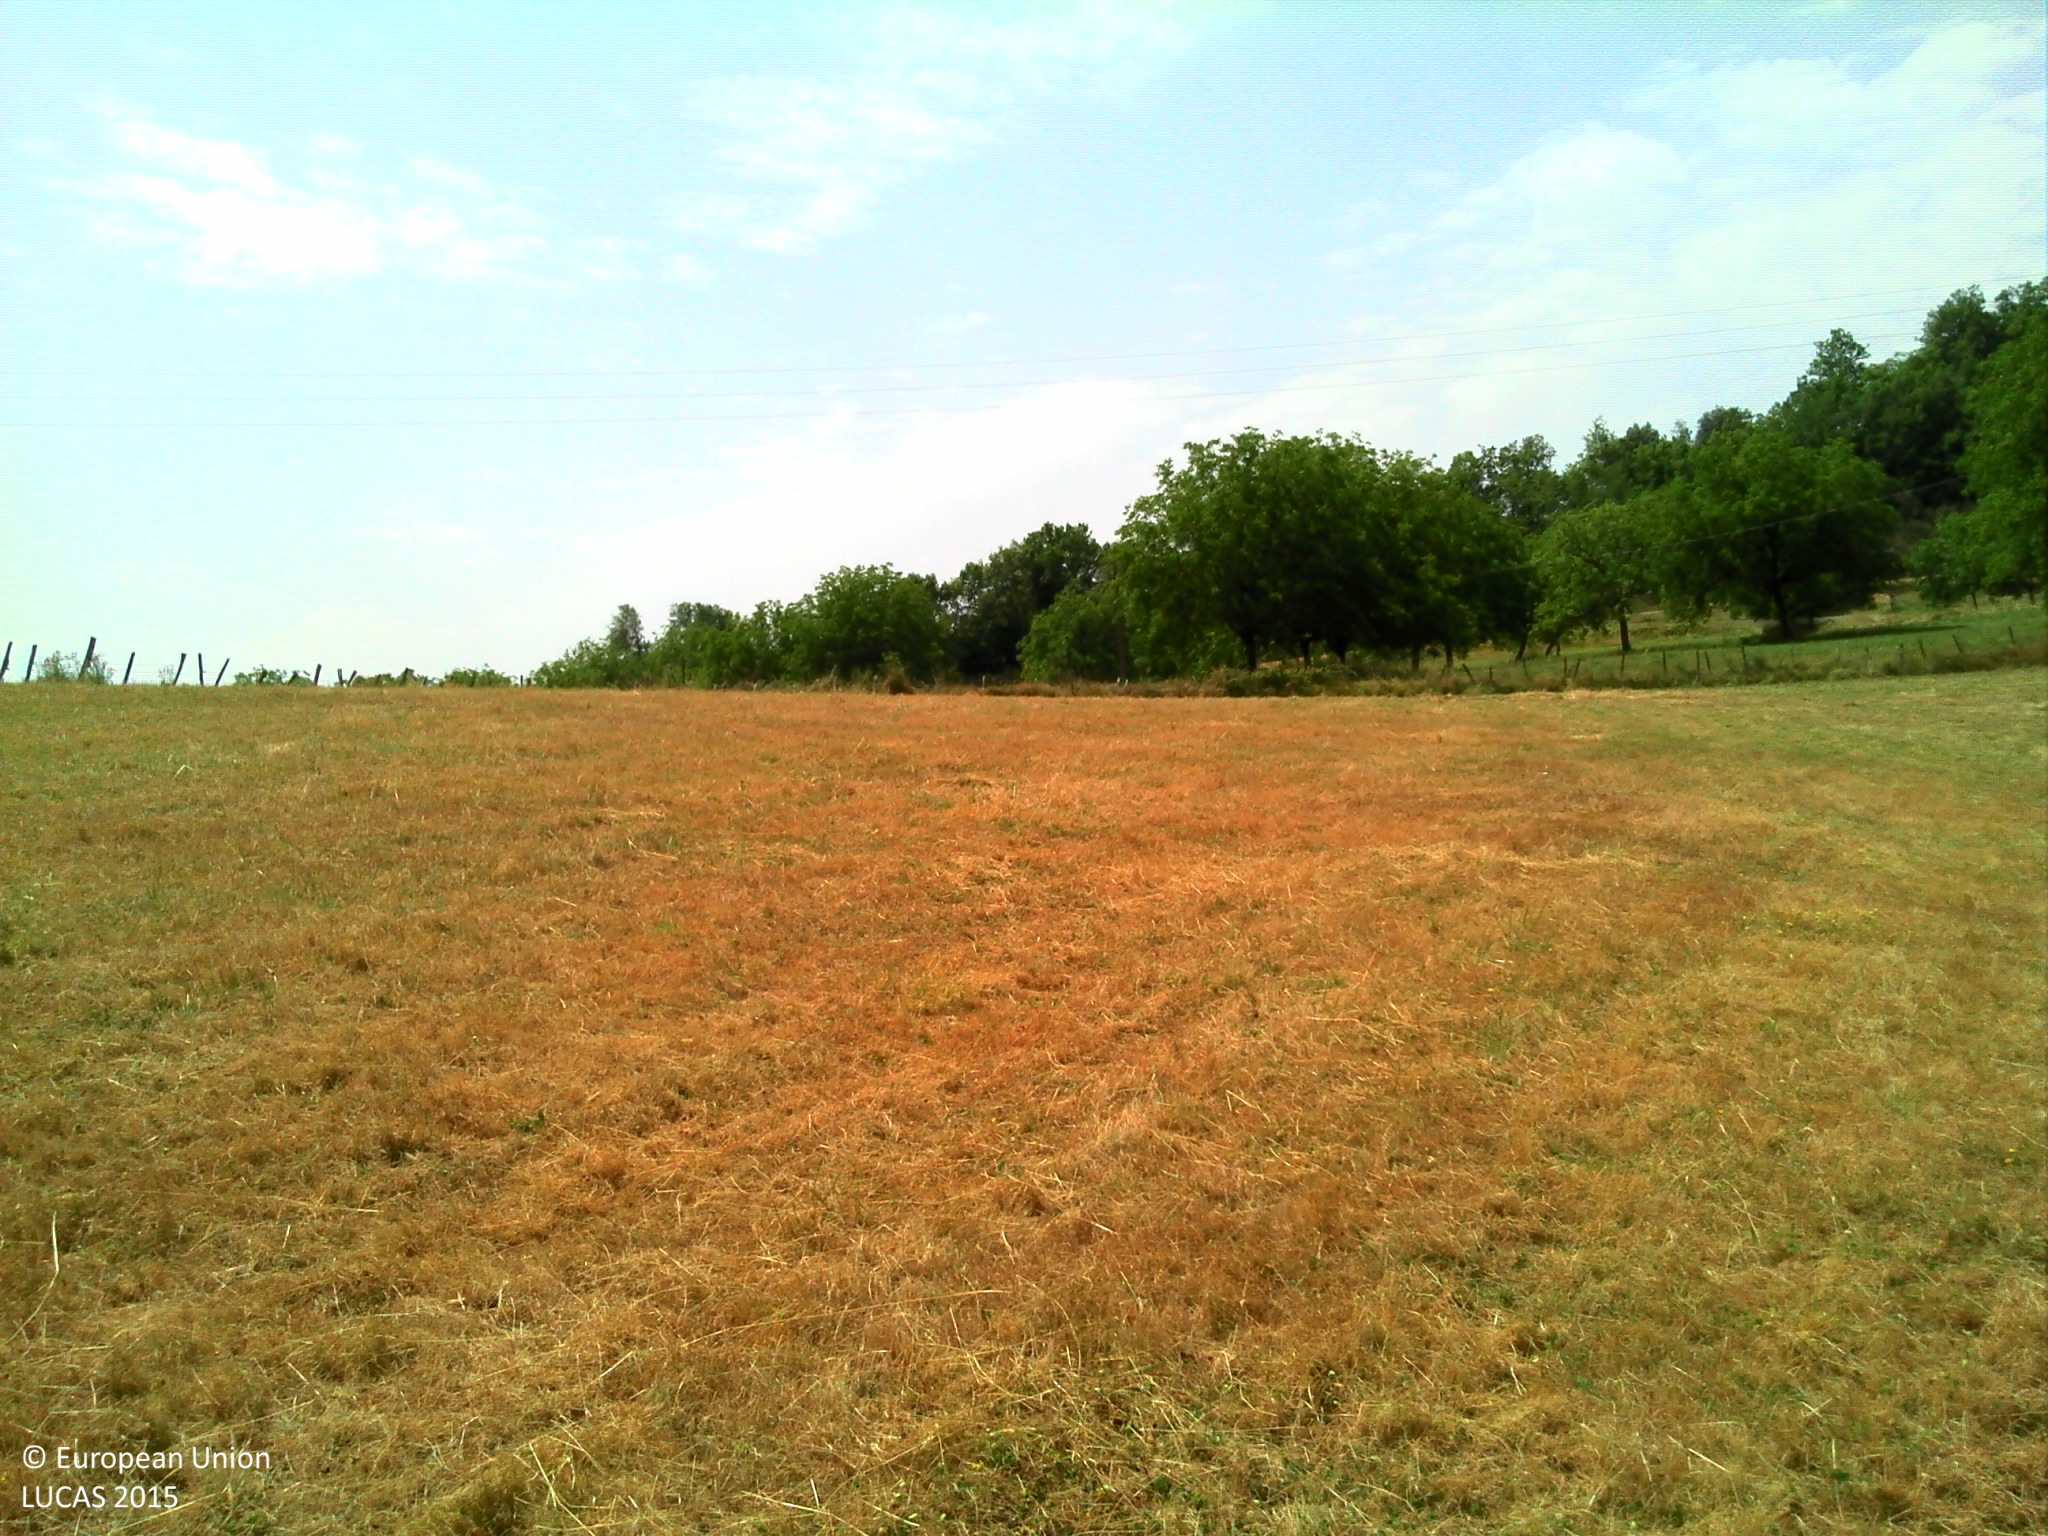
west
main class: Grassland
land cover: Grassland without tree/shrub cover
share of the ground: > 75 %
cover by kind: herbaceous plants 100 %
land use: Agriculture (excluding fallow land and kitchen gardens)
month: July
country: FR
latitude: 45.1863
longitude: 1.1476
